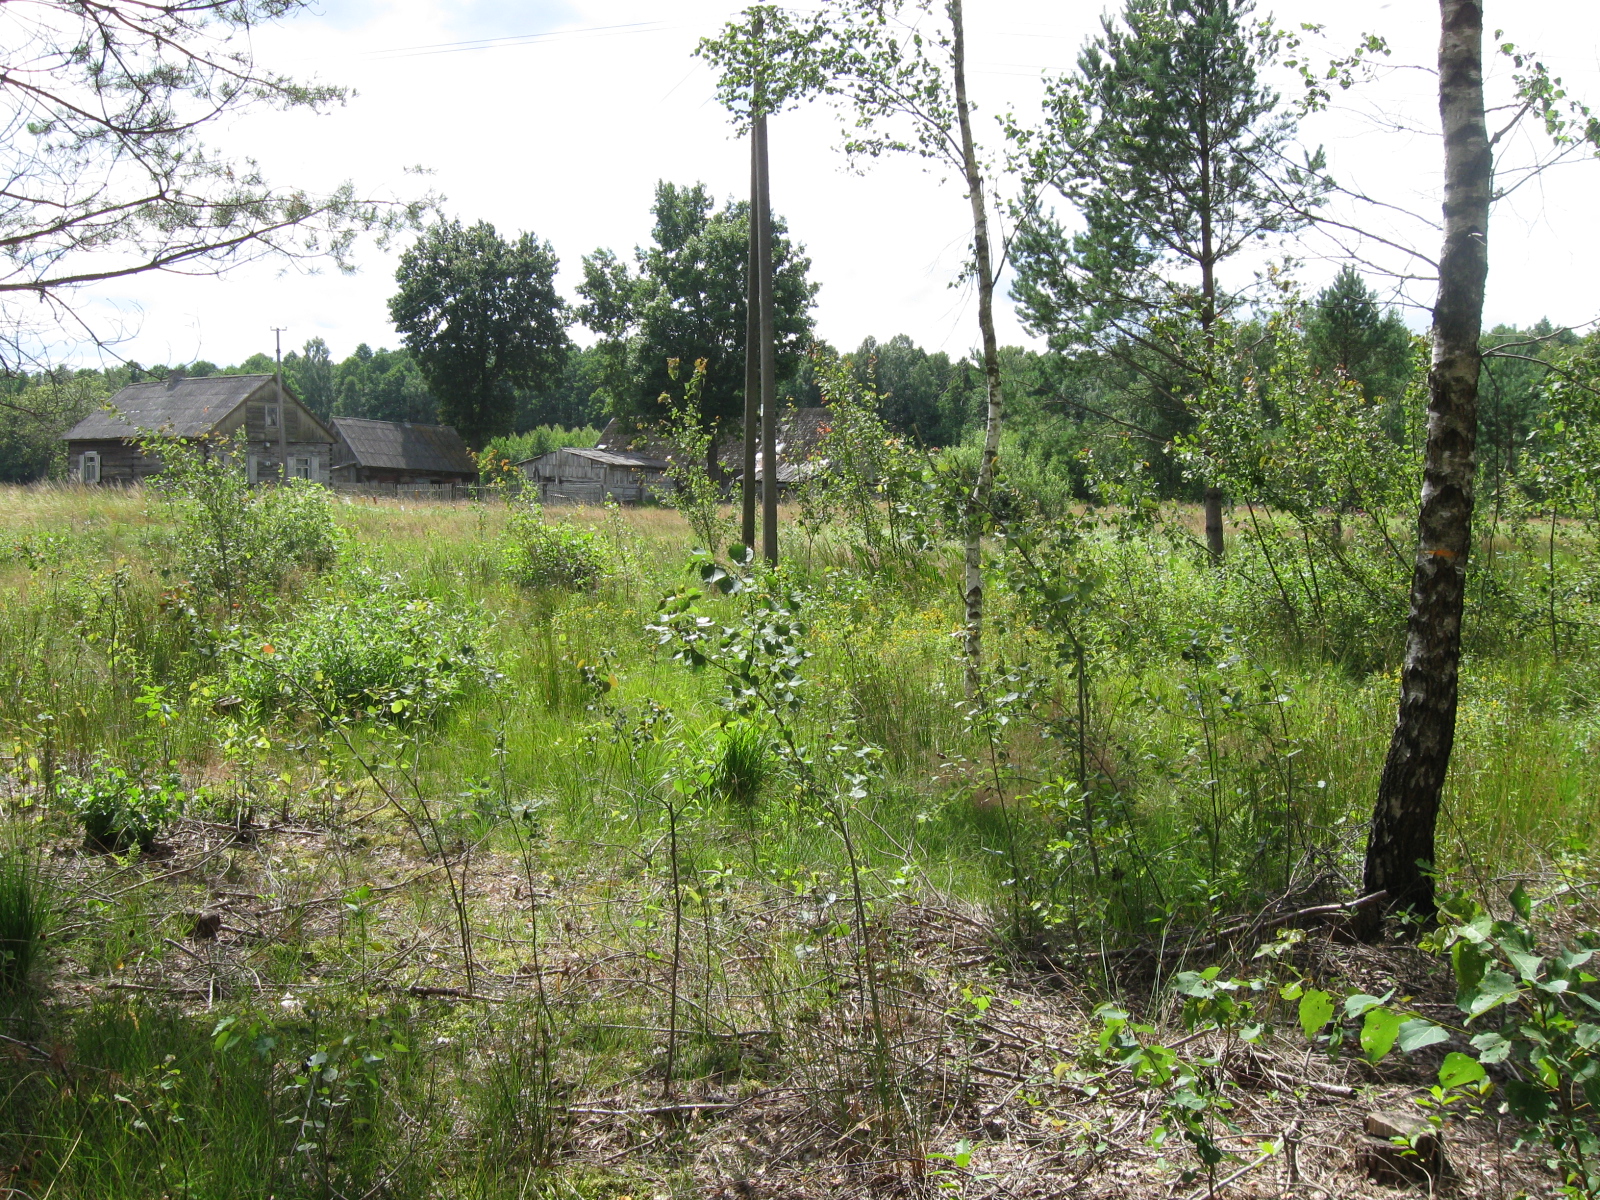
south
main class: Woodland
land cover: Pine dominated mixed woodland
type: hemiboreal forest and nemoral coniferous forest and mixed broadleaved-coniferous forest
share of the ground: 50 - 75 %
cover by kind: broadleaved forest trees 35 %, coniferous forest trees 25 %, herbaceous plants 25 %, unconsolidated bare surface 10 %, lichens and mosses 5 %
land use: Forestry
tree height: < 5 m
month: July
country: LT
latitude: 54.9692
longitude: 23.4036
